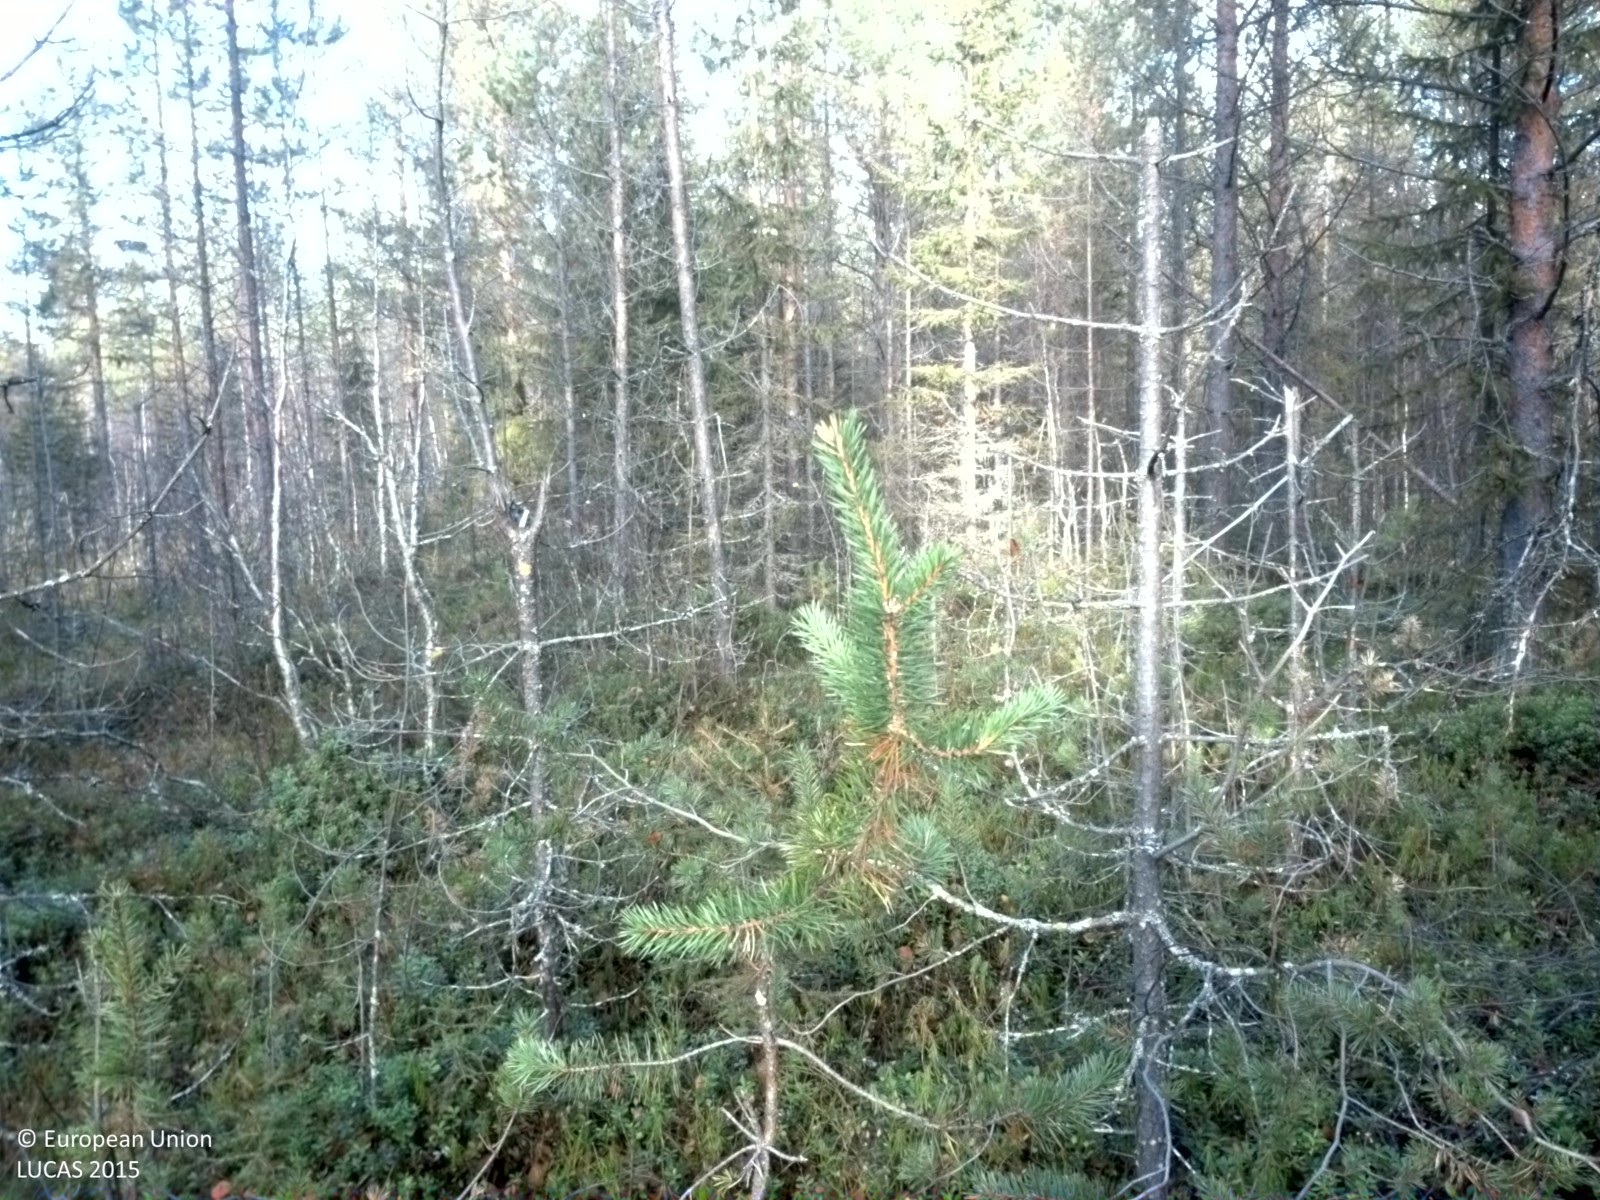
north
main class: Woodland
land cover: Pine dominated coniferous woodland
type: boreal forest
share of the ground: 25 - 50 %
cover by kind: shrubs 60 %, coniferous forest trees 35 %, broadleaved forest trees 5 %
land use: Forestry
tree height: > 5 m
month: October
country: SE
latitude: 65.9587
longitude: 22.2286
